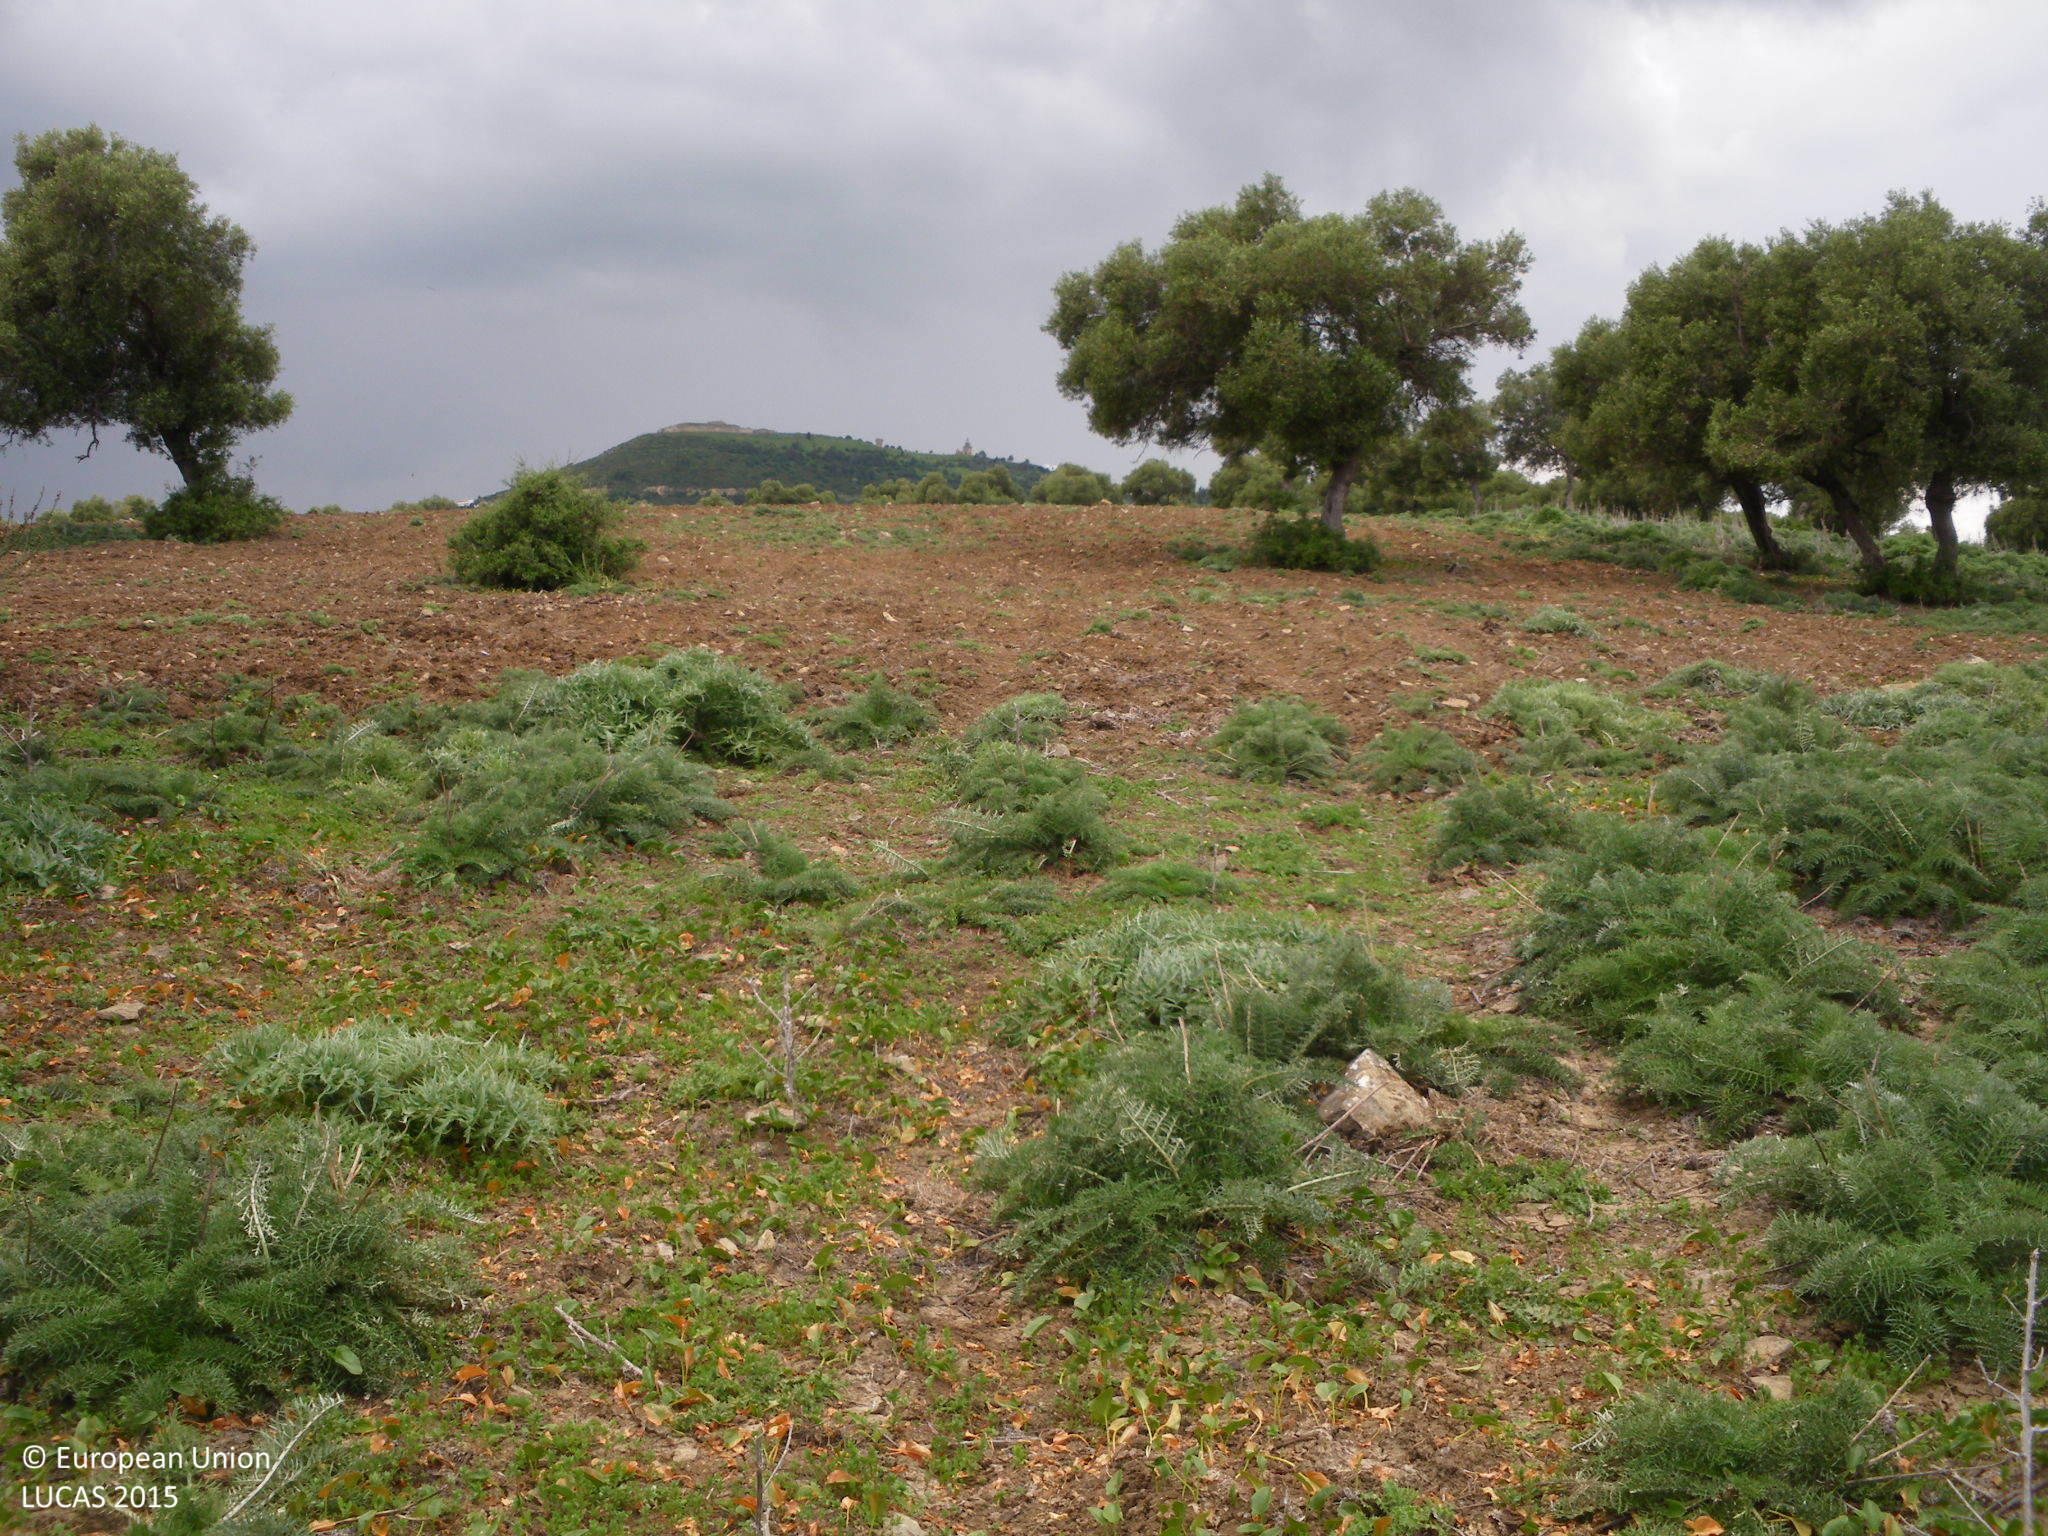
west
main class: Cropland
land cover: Olive groves
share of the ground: 25 - 50 %
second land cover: Spontaneously vegetated surfaces
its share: > 75 %
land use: Agriculture (excluding fallow land and kitchen gardens)
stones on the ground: 10 - 25 %
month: April
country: ES
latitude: 36.4551
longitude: -5.9040
